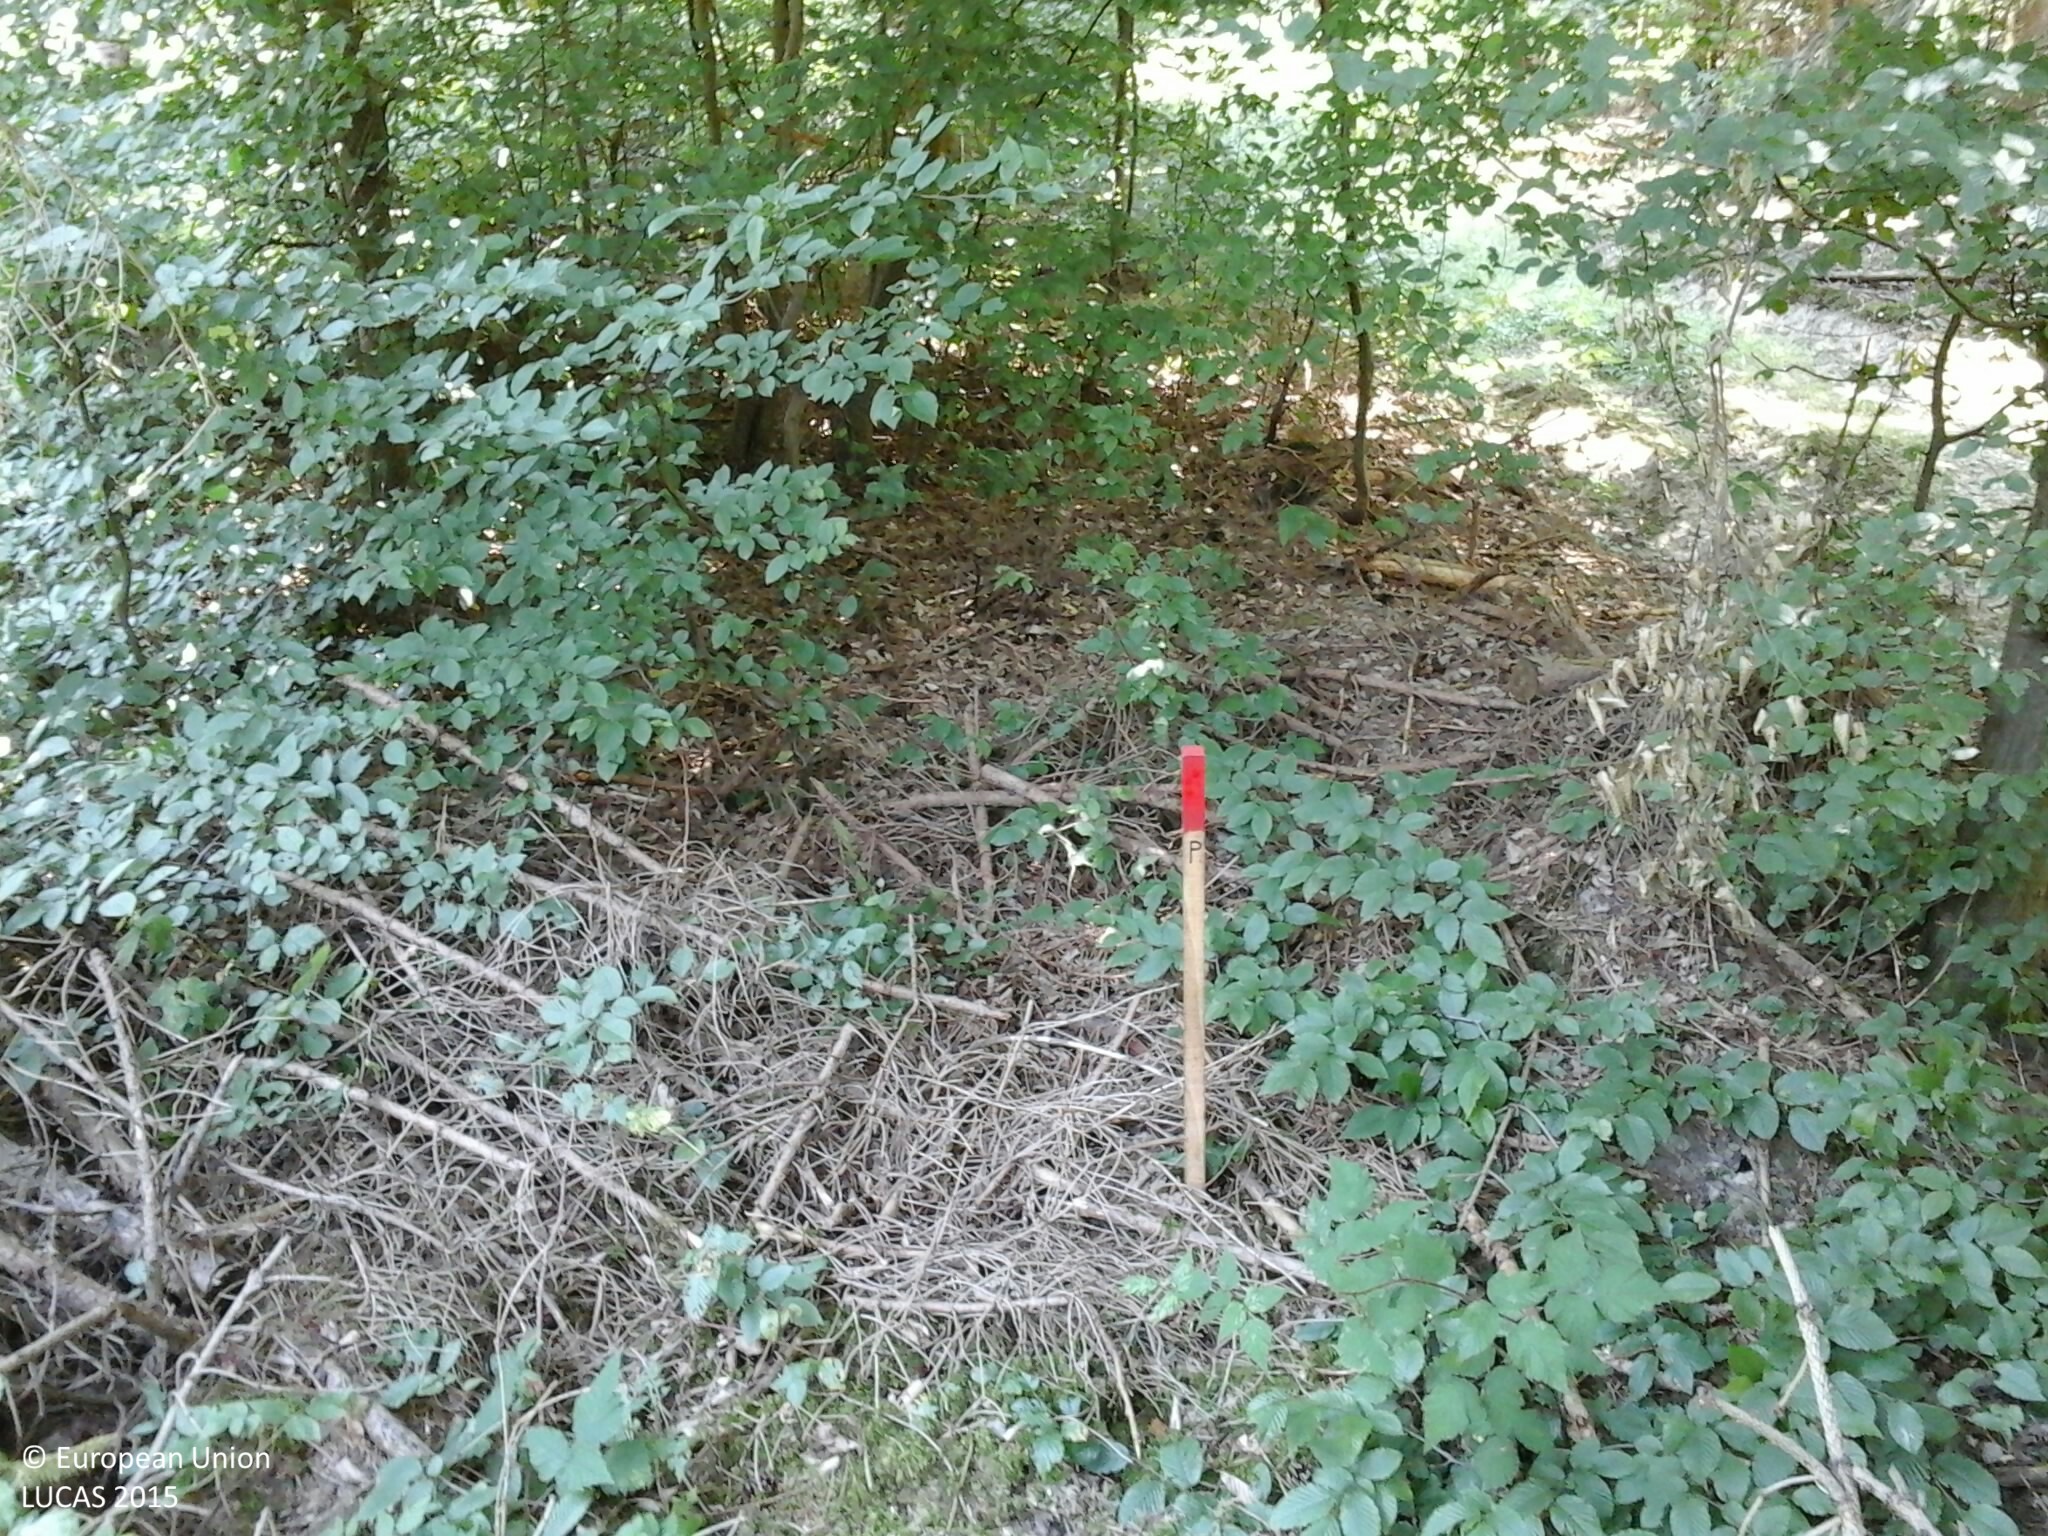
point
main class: Woodland
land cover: Pine dominated coniferous woodland
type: hemiboreal forest and nemoral coniferous forest and mixed broadleaved-coniferous forest
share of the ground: > 75 %
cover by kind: coniferous forest trees 70 %, broadleaved forest trees 20 %, shrubs 10 %
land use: Forestry
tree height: > 5 m
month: July
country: HU
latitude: 46.9424
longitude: 16.2944
